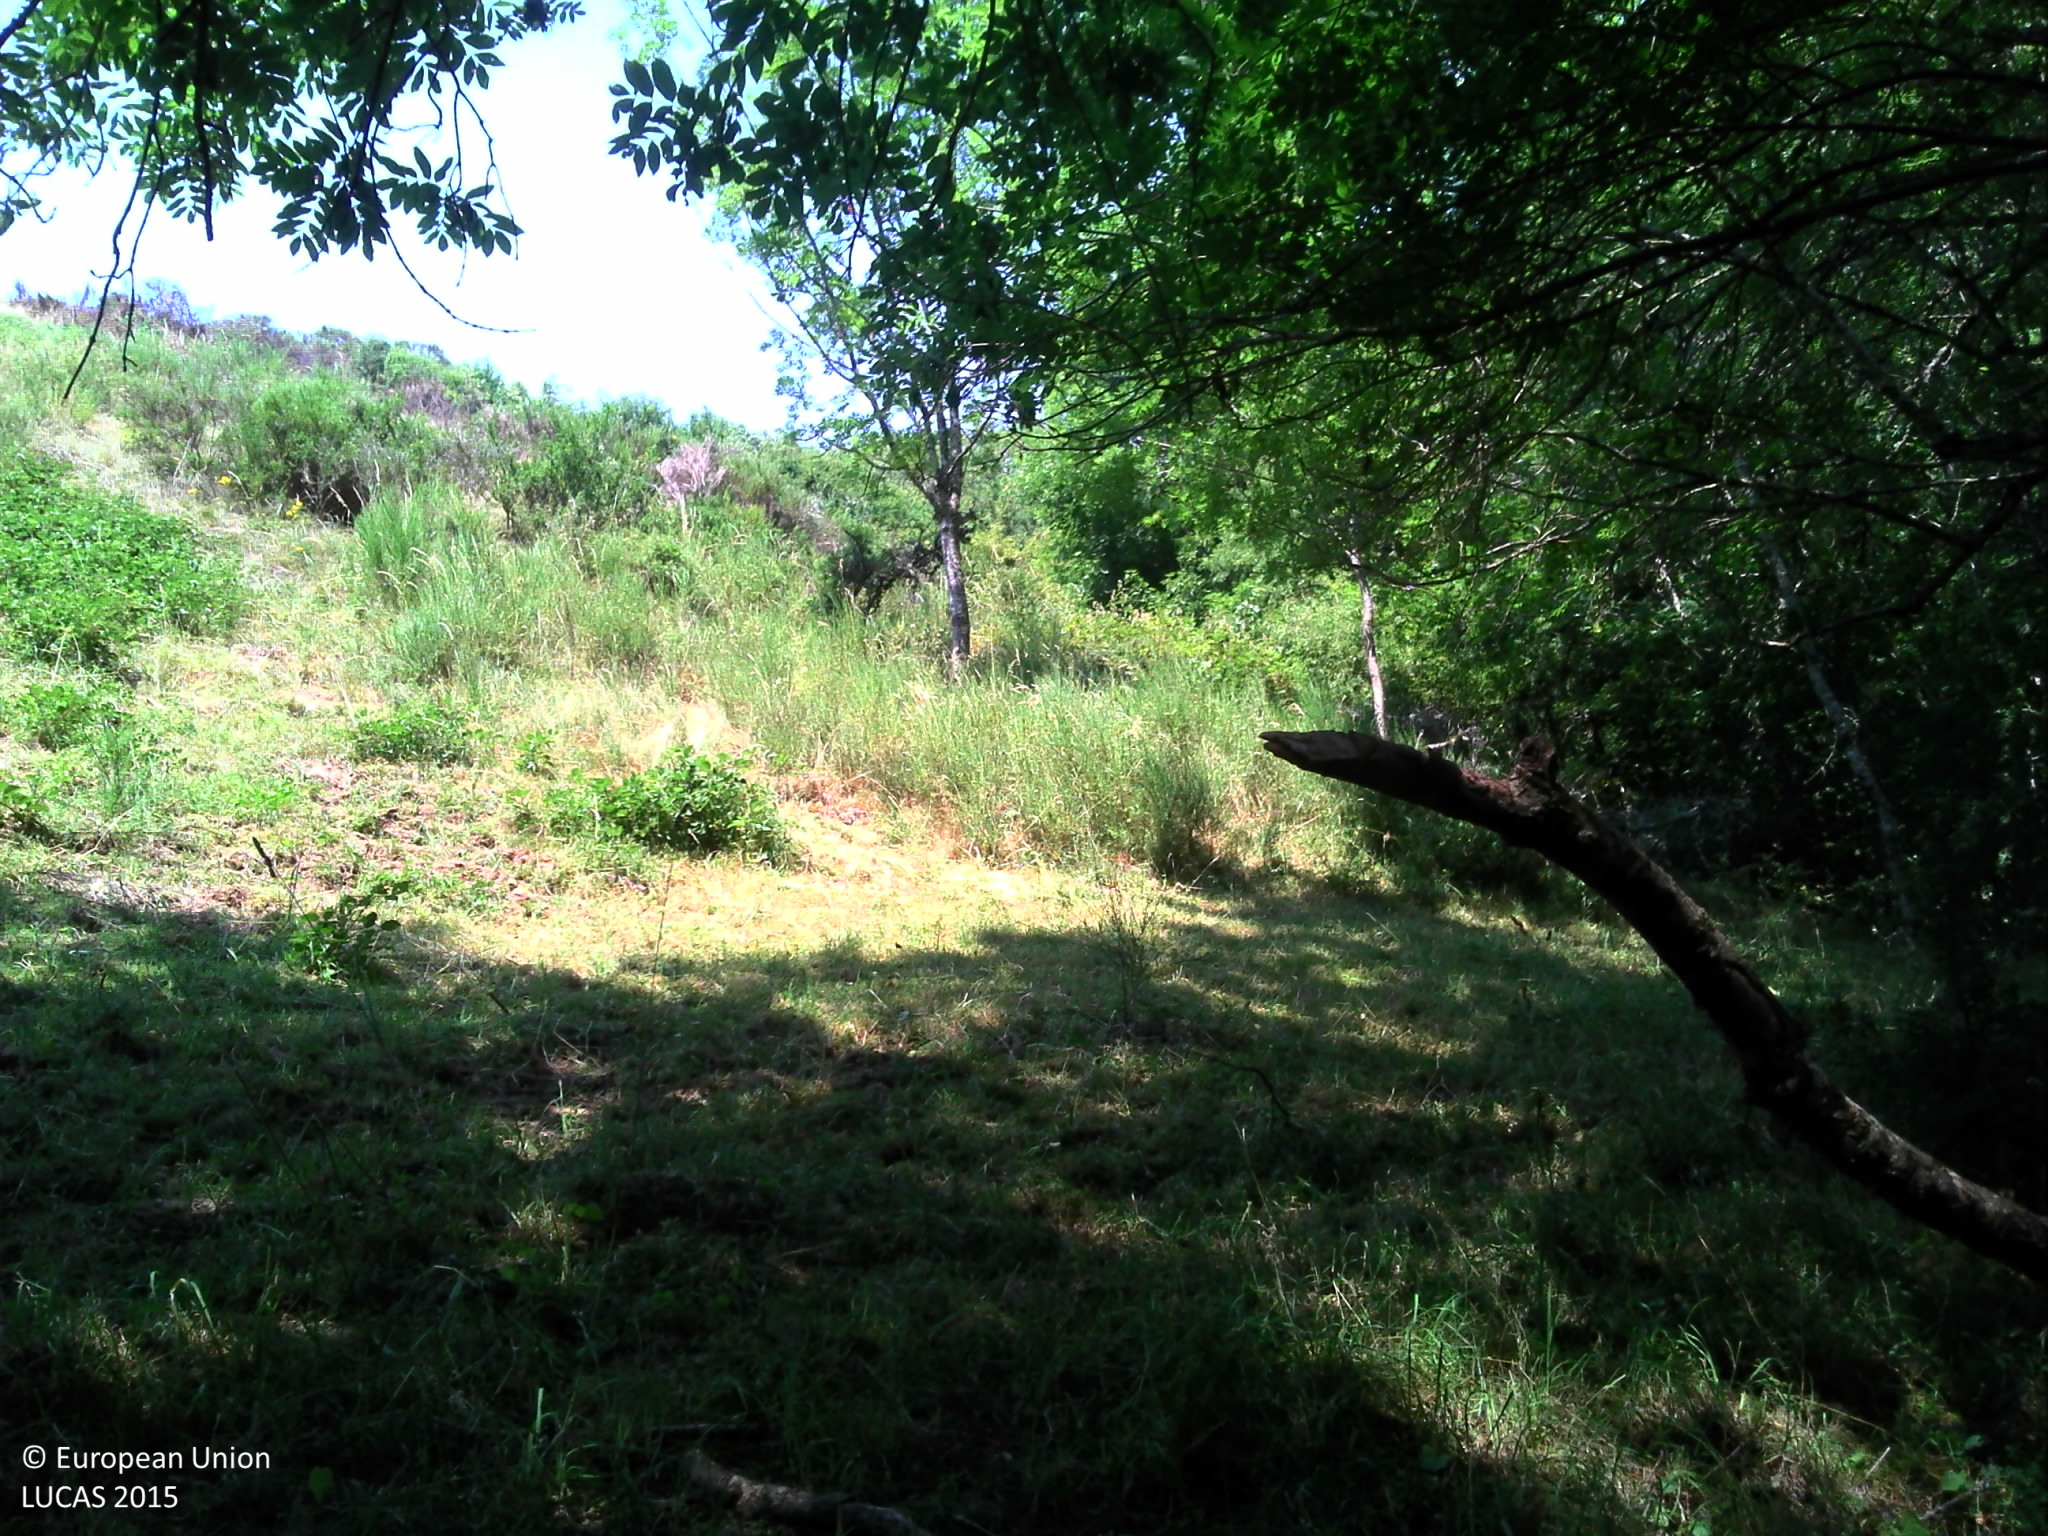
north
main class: Woodland
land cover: Spruce dominated mixed woodland
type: alpine coniferous forest
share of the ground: > 75 %
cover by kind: coniferous forest trees 60 %, broadleaved forest trees 30 %, shrubs 10 %
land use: Residential
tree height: > 5 m
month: July
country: FR
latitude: 44.8562
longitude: 3.0049
